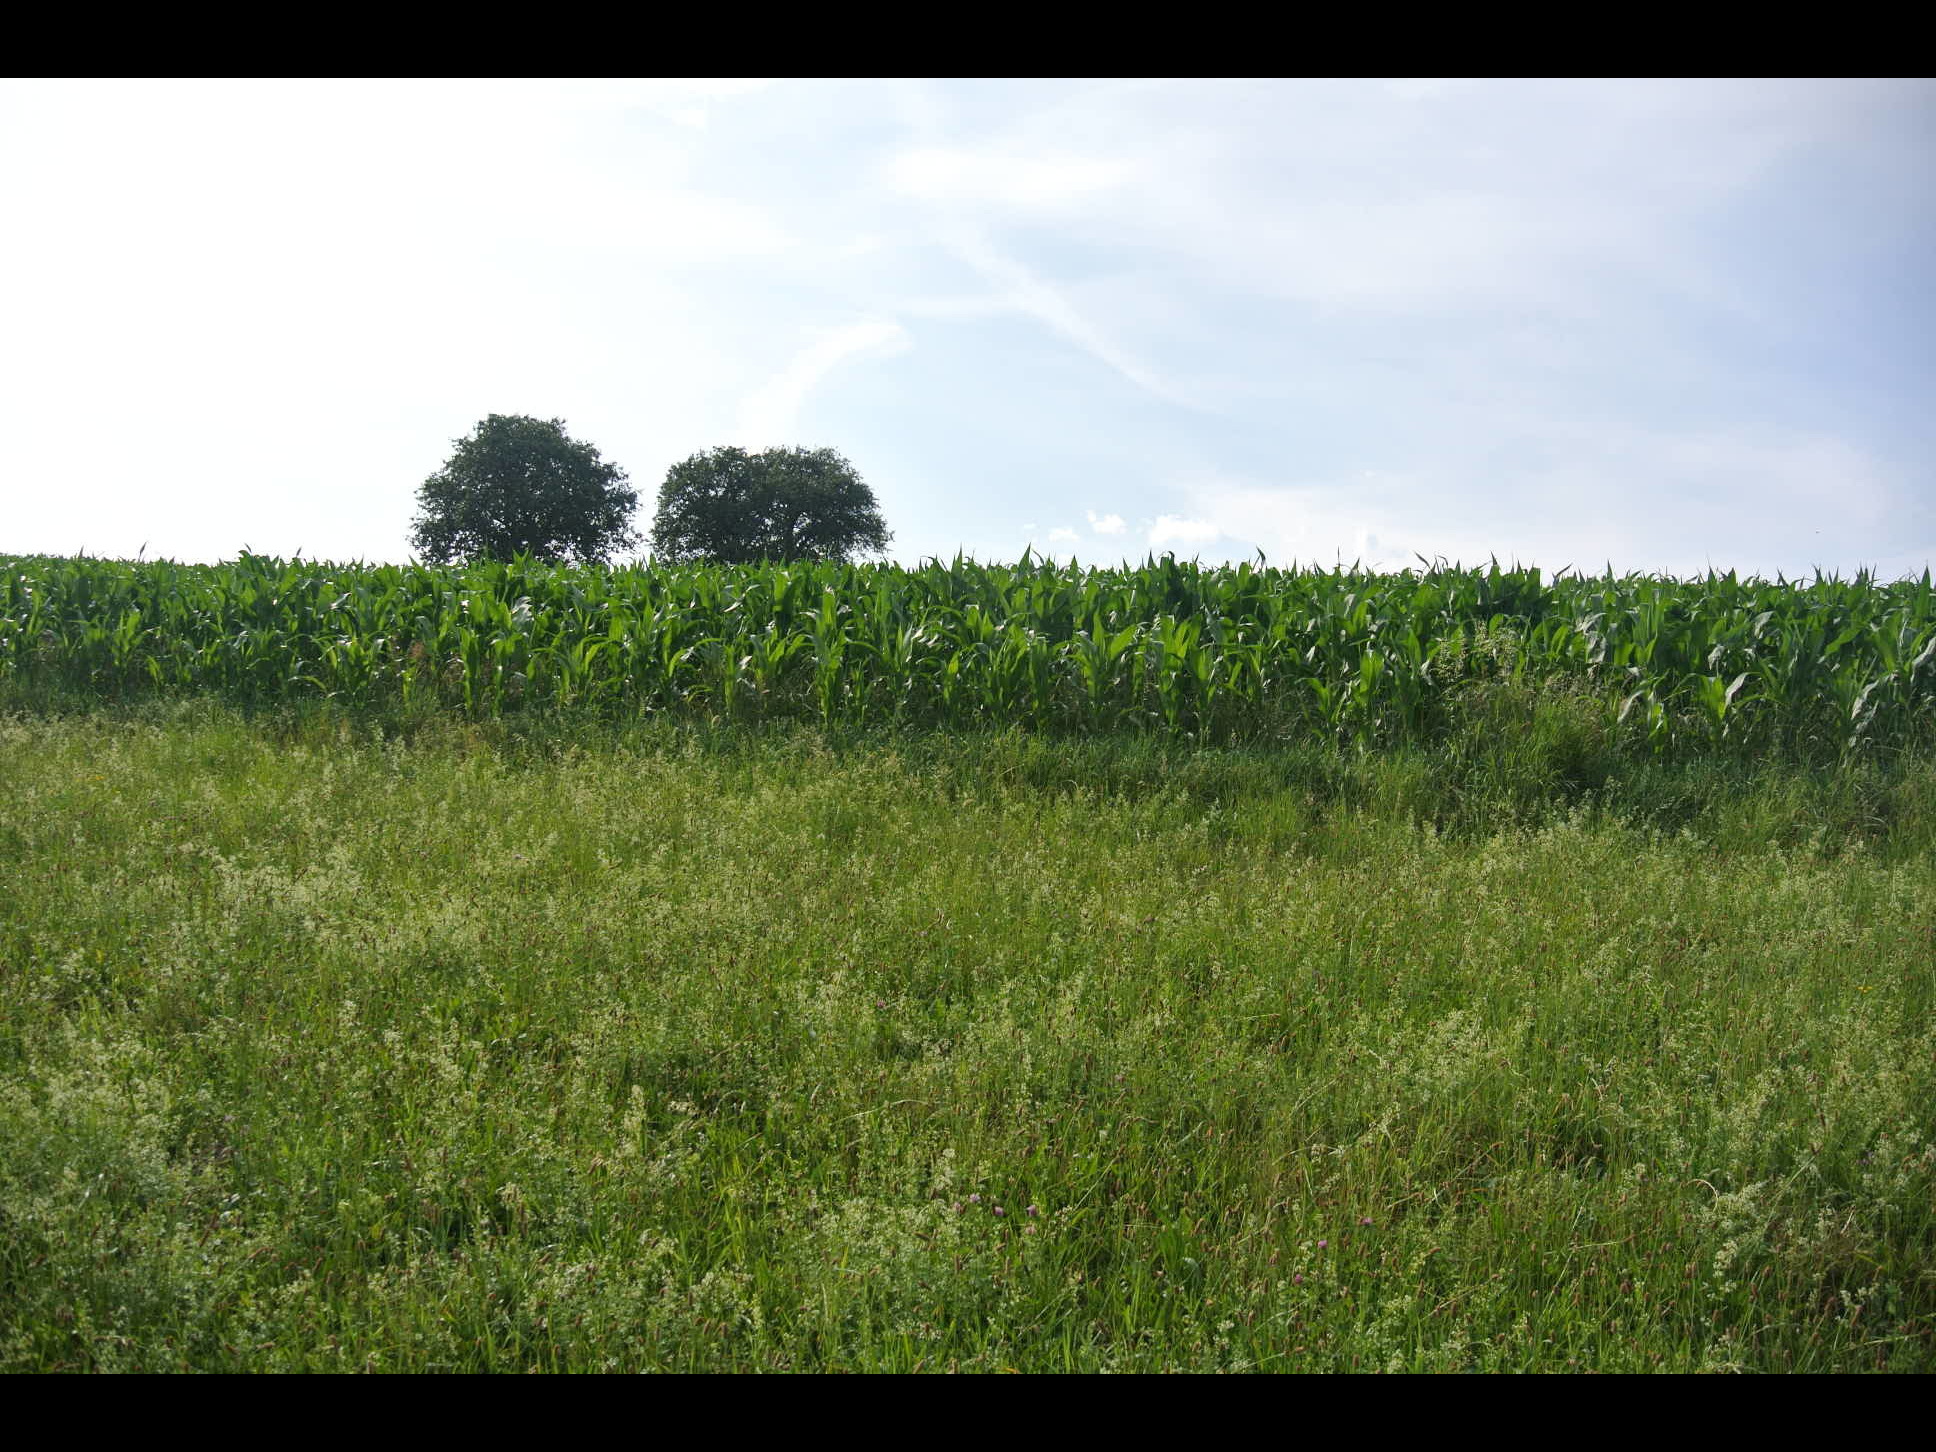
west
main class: Grassland
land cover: Grassland without tree/shrub cover
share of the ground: > 75 %
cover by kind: herbaceous plants 100 %
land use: Agriculture (excluding fallow land and kitchen gardens)
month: July
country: AT
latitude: 47.6583
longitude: 16.0879
